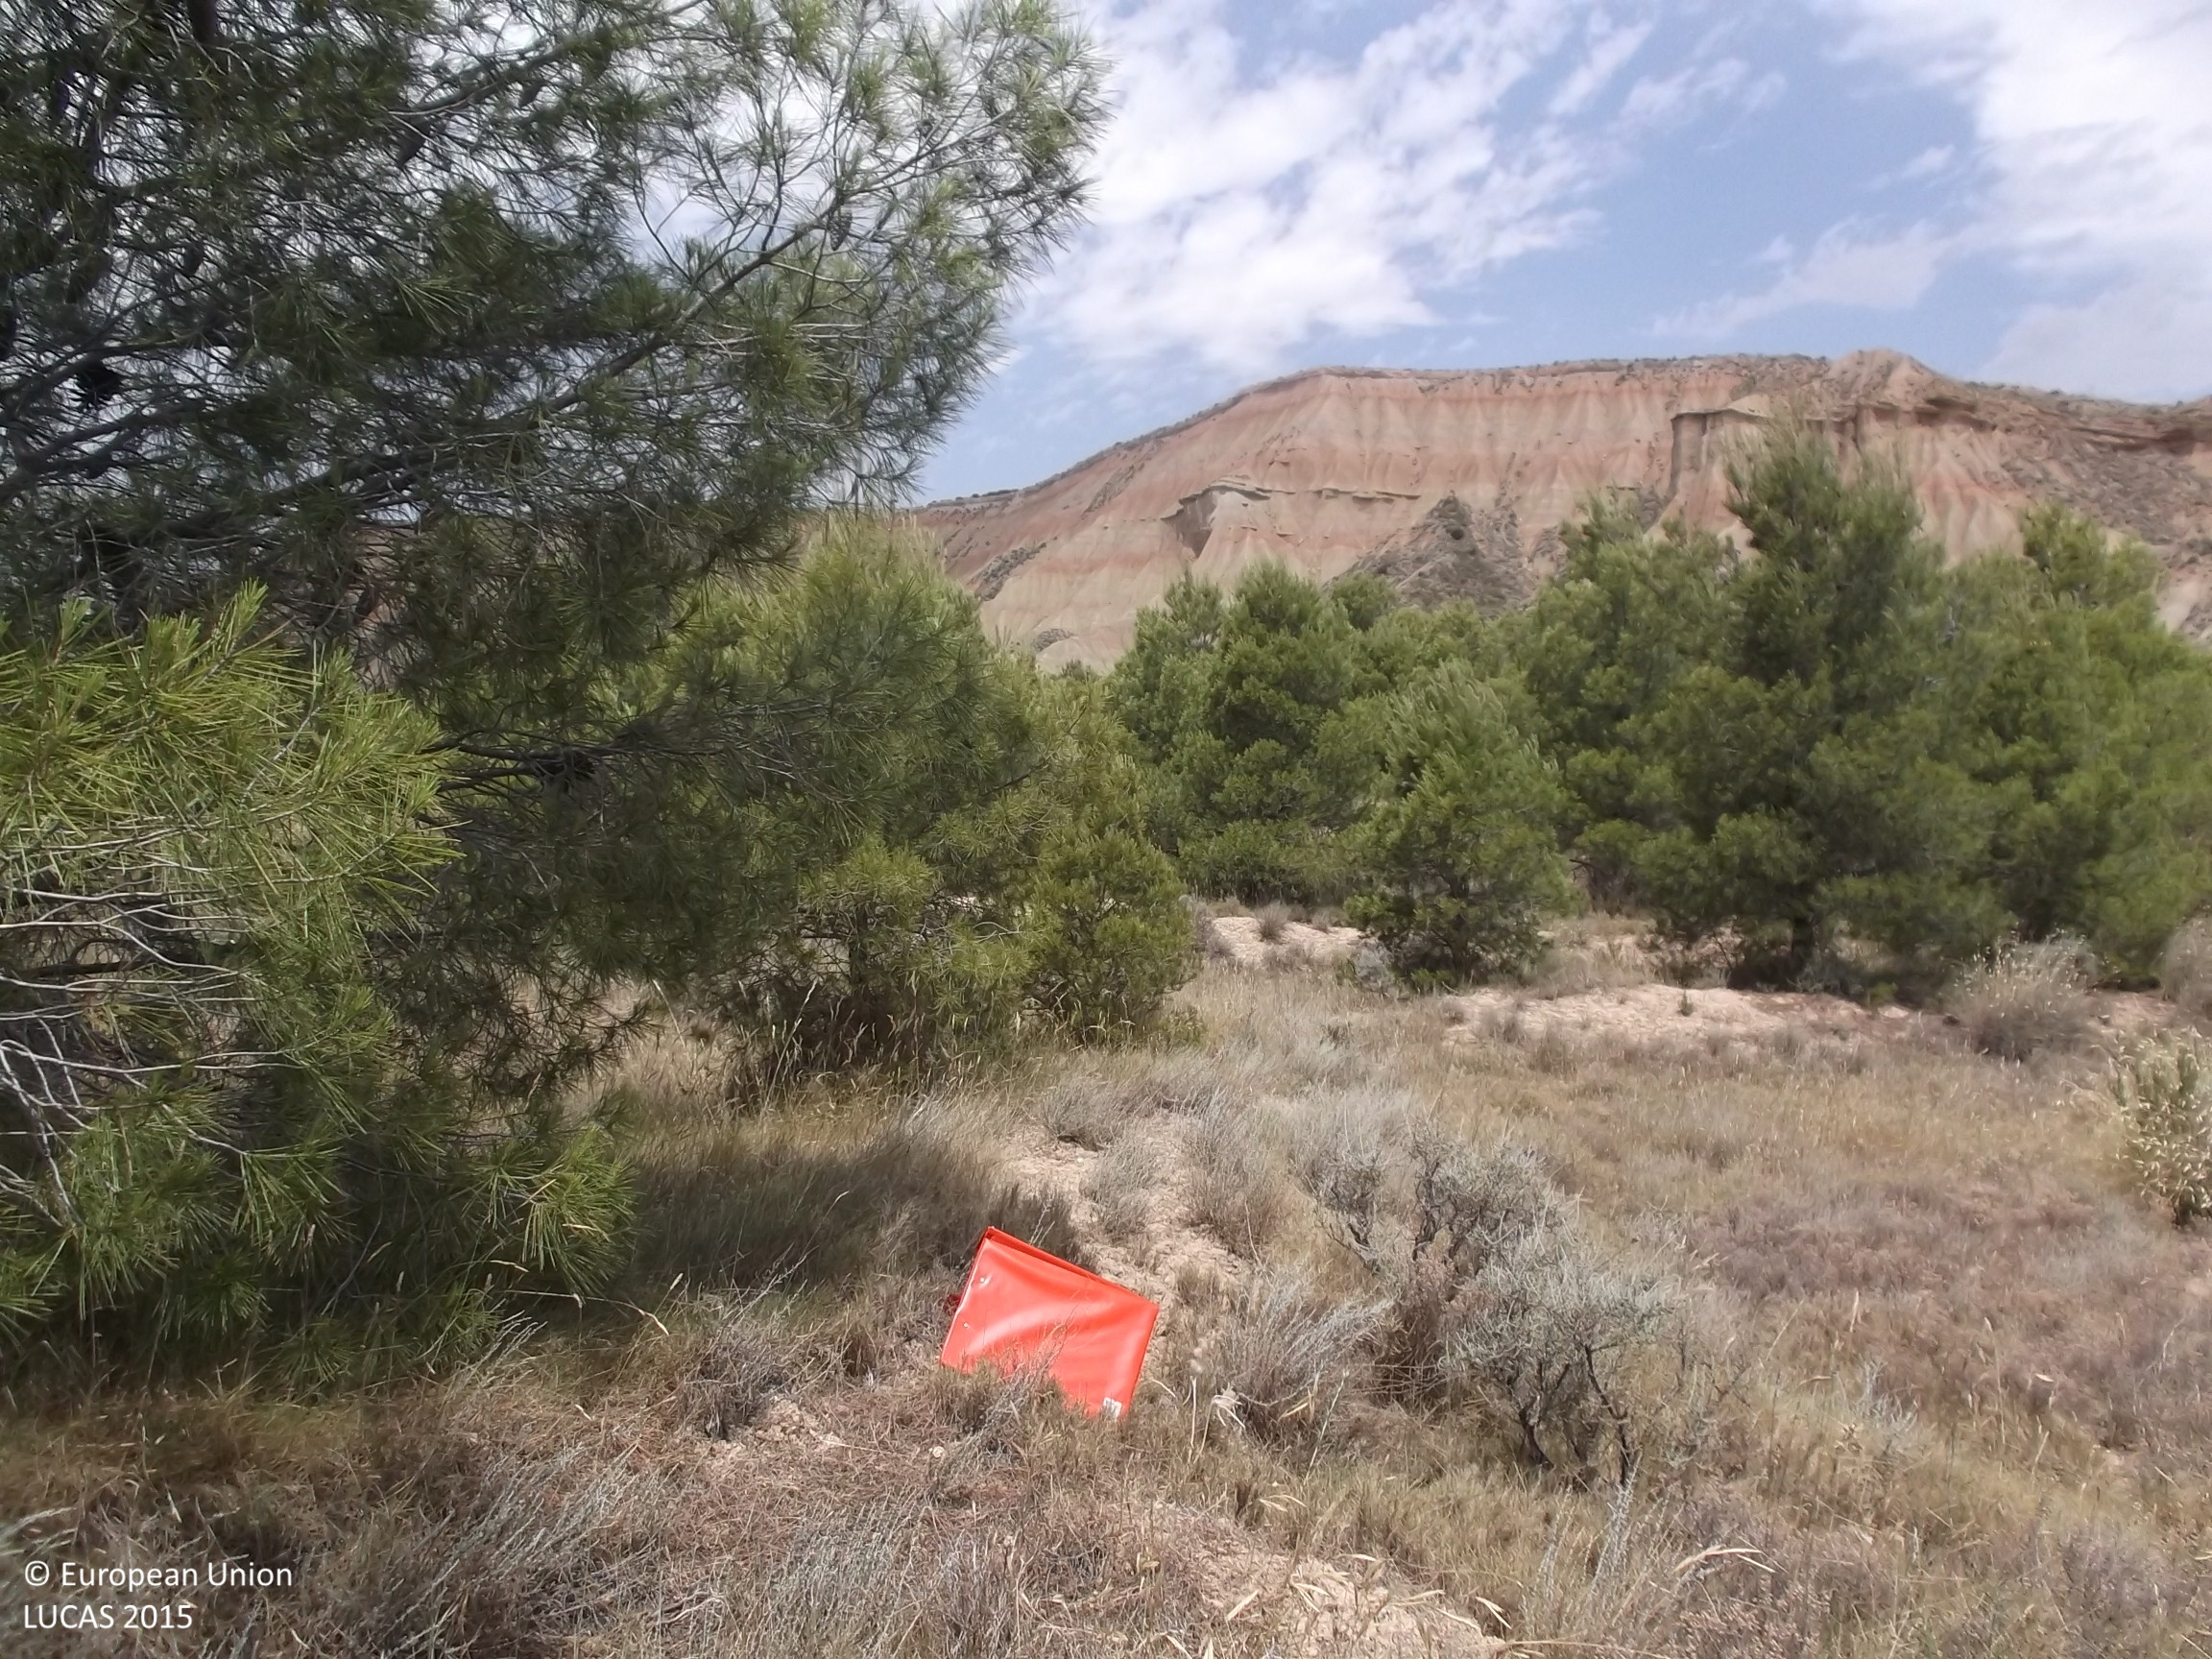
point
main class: Woodland
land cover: Pine dominated coniferous woodland
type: coniferous forest of the mediterranean region
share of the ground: 50 - 75 %
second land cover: Shrubland without tree cover
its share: 10 - 25 %
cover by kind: coniferous forest trees 70 %, shrubs 15 %, herbaceous plants 10 %, unconsolidated bare surface 5 %
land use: Forestry
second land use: Agriculture (excluding fallow land and kitchen gardens)
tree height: < 5 m
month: July
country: ES
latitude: 42.2095
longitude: -1.5518
